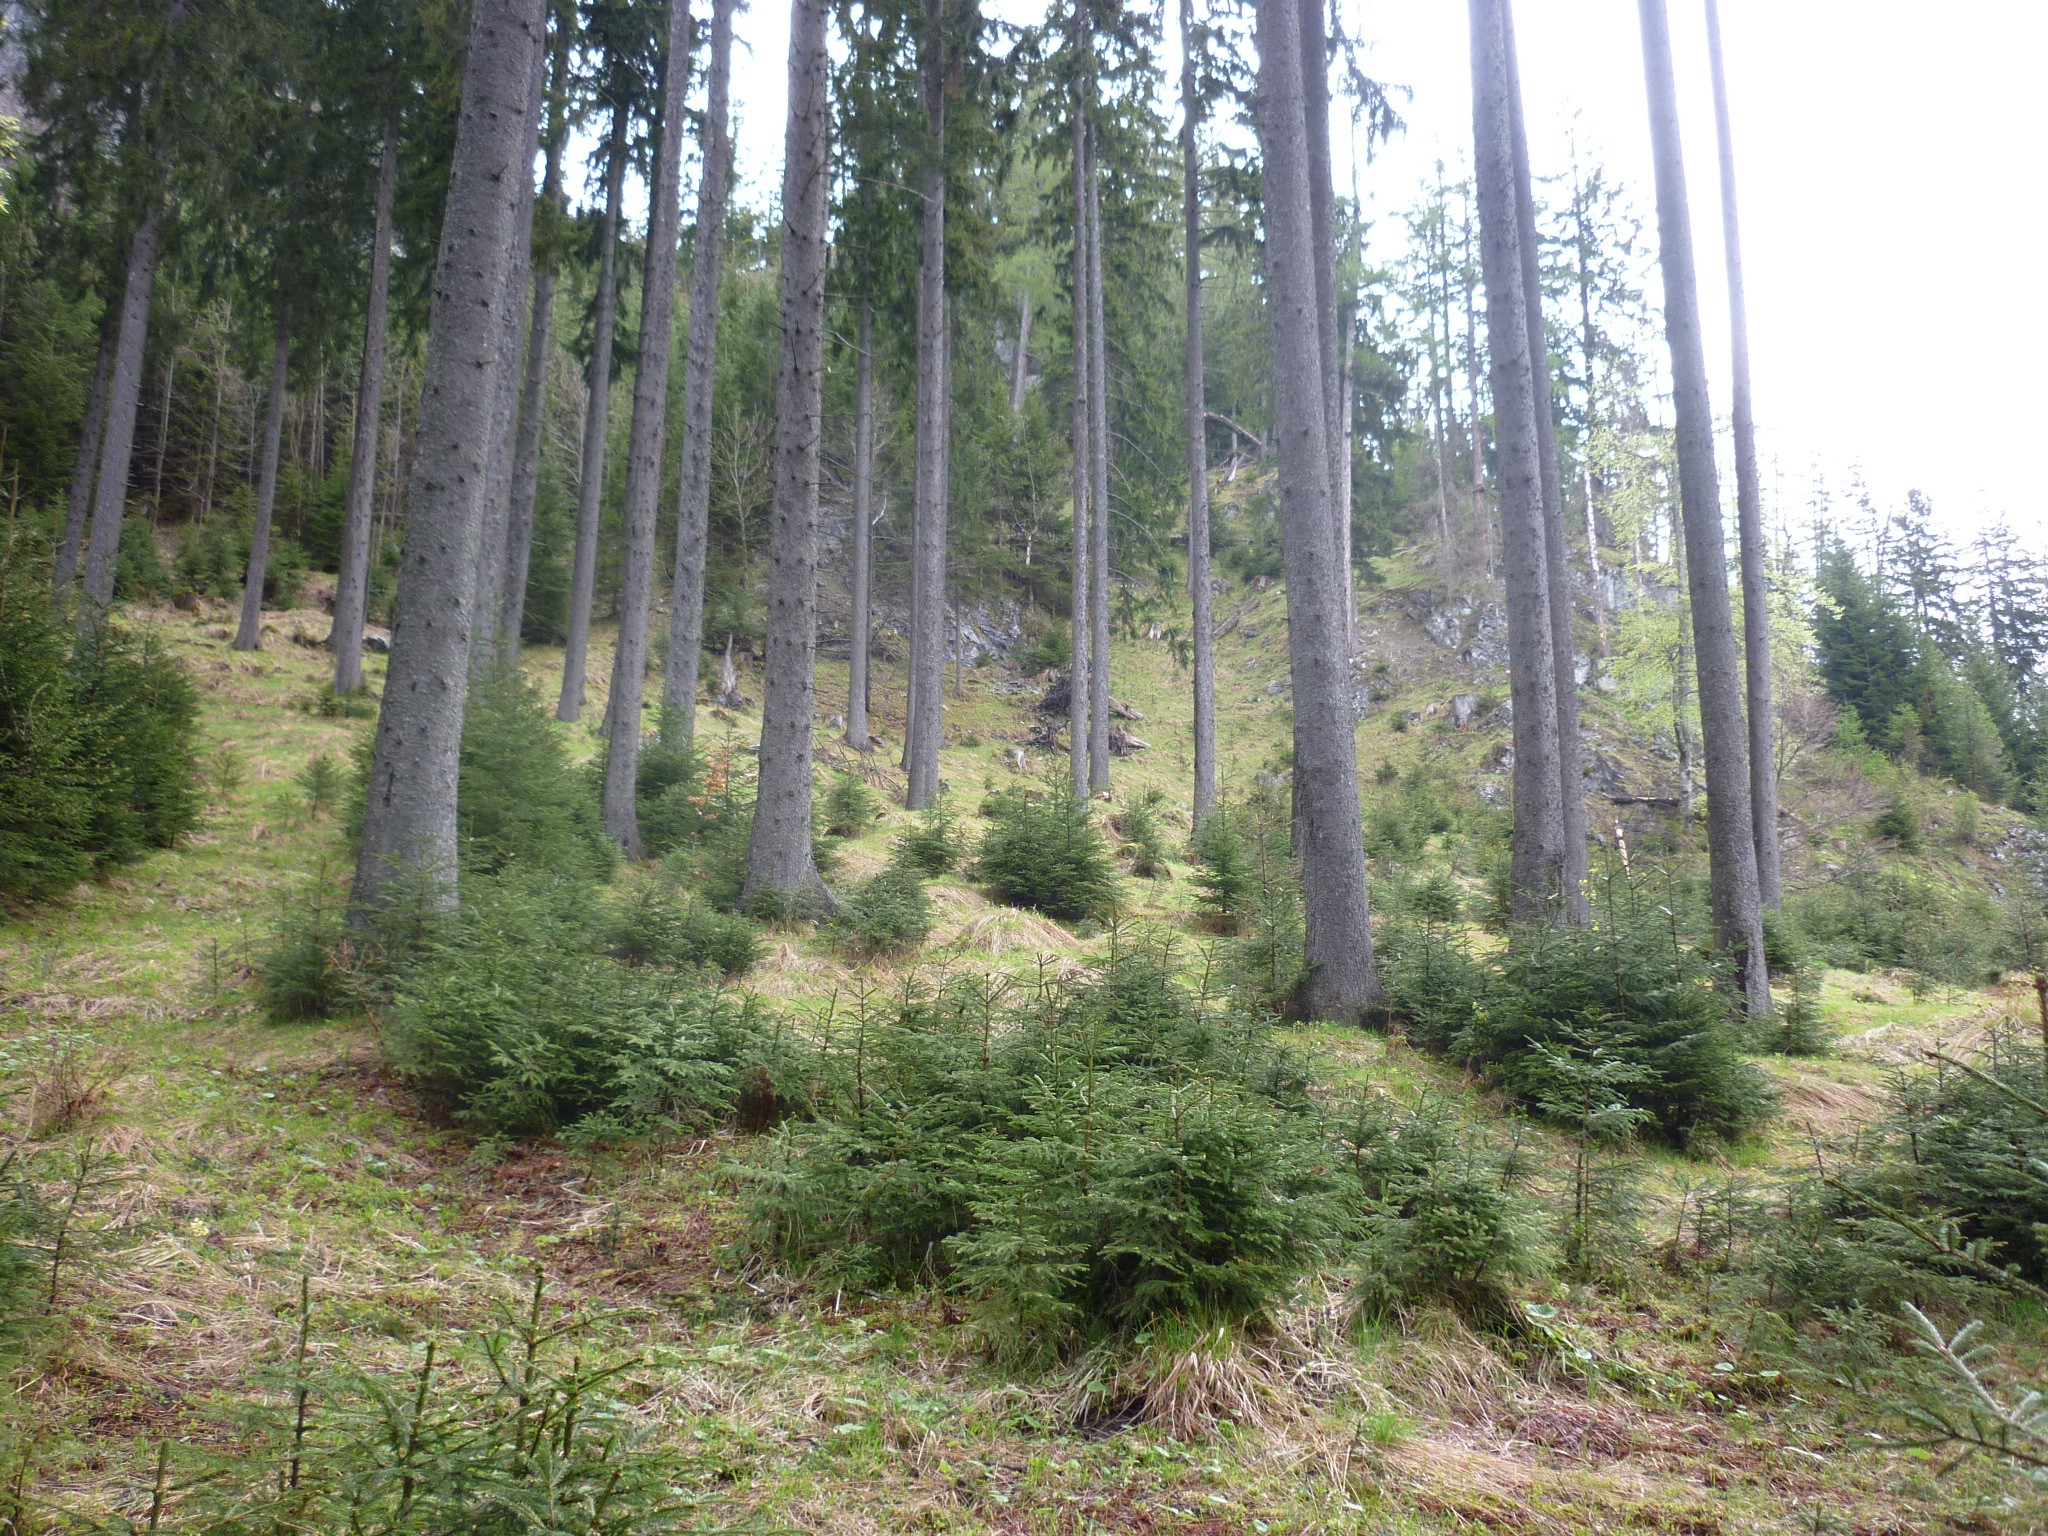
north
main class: Woodland
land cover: Spruce dominated coniferous woodland
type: alpine coniferous forest
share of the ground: 50 - 75 %
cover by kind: coniferous forest trees 70 %, herbaceous plants 20 %, lichens and mosses 10 %
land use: Forestry
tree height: > 5 m
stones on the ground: < 10 %
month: May
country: AT
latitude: 47.6424
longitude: 14.5652
